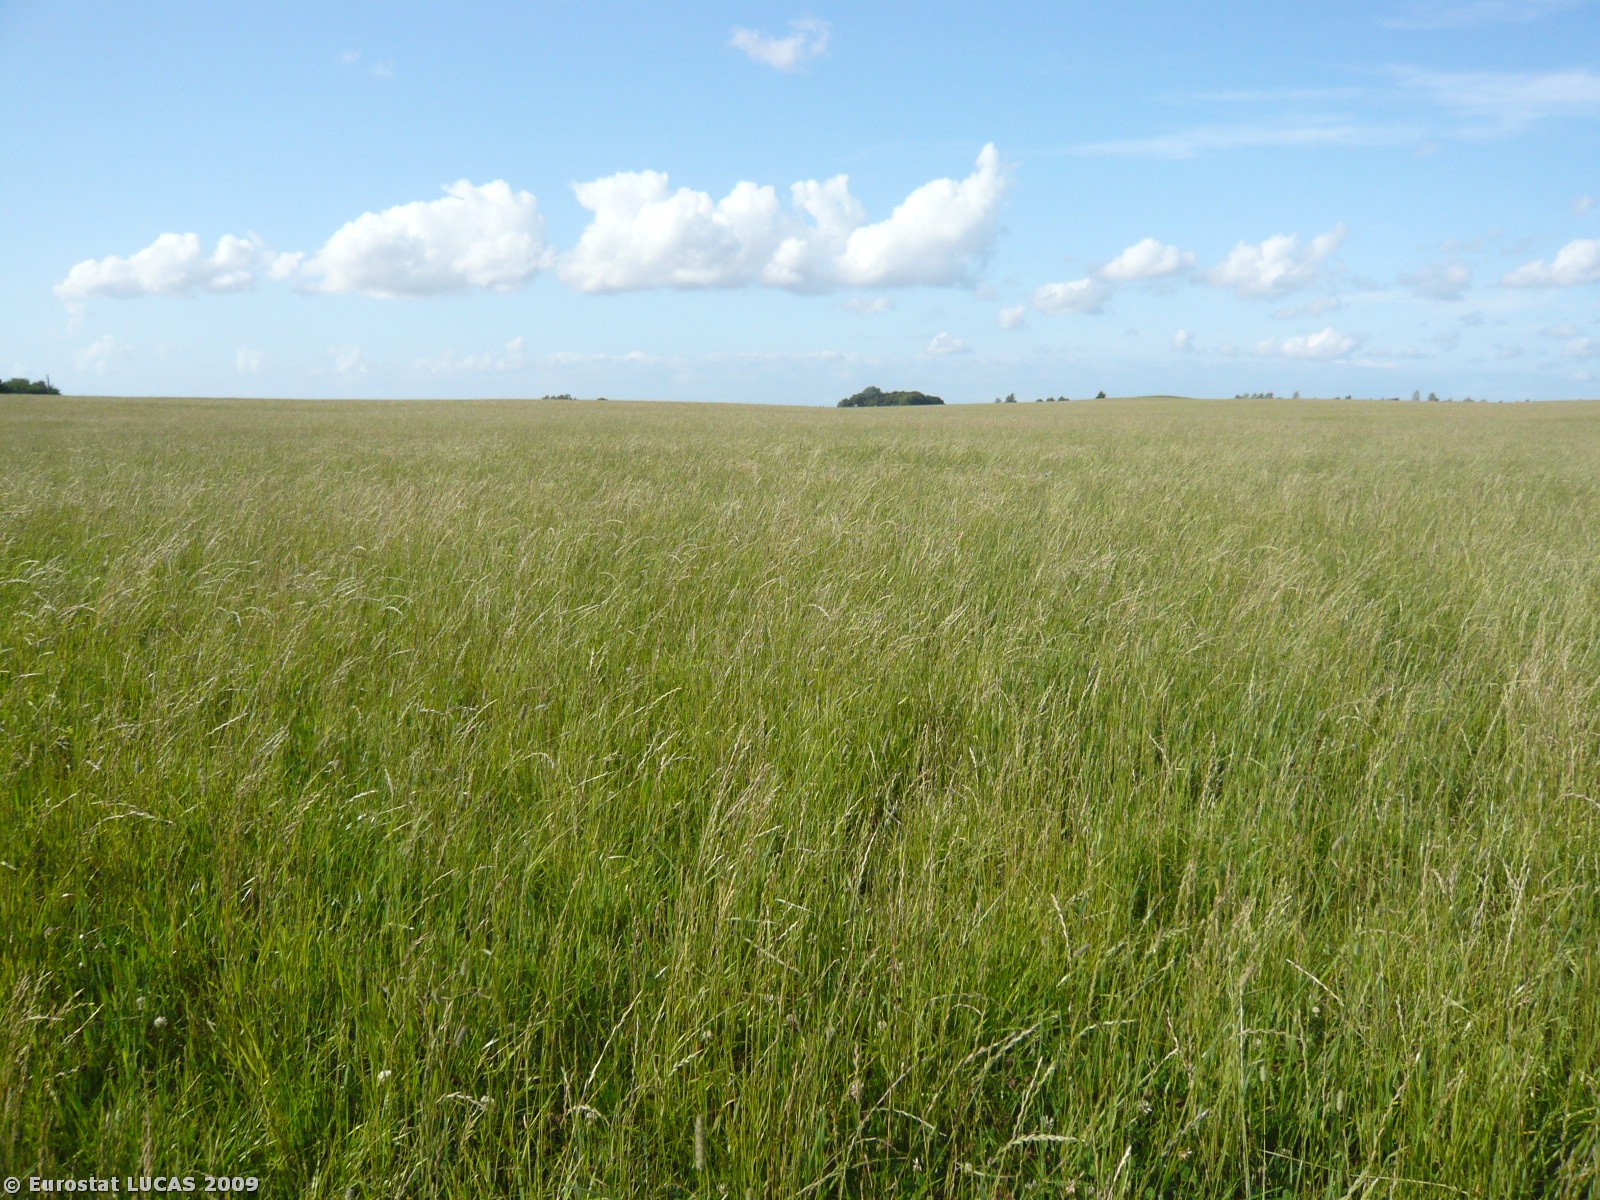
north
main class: Cropland
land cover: Temporary grasslands
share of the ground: > 75 %
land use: Agriculture (excluding fallow land and kitchen gardens)
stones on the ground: < 10 %
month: July
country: DK
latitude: 55.8977
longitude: 12.2849
